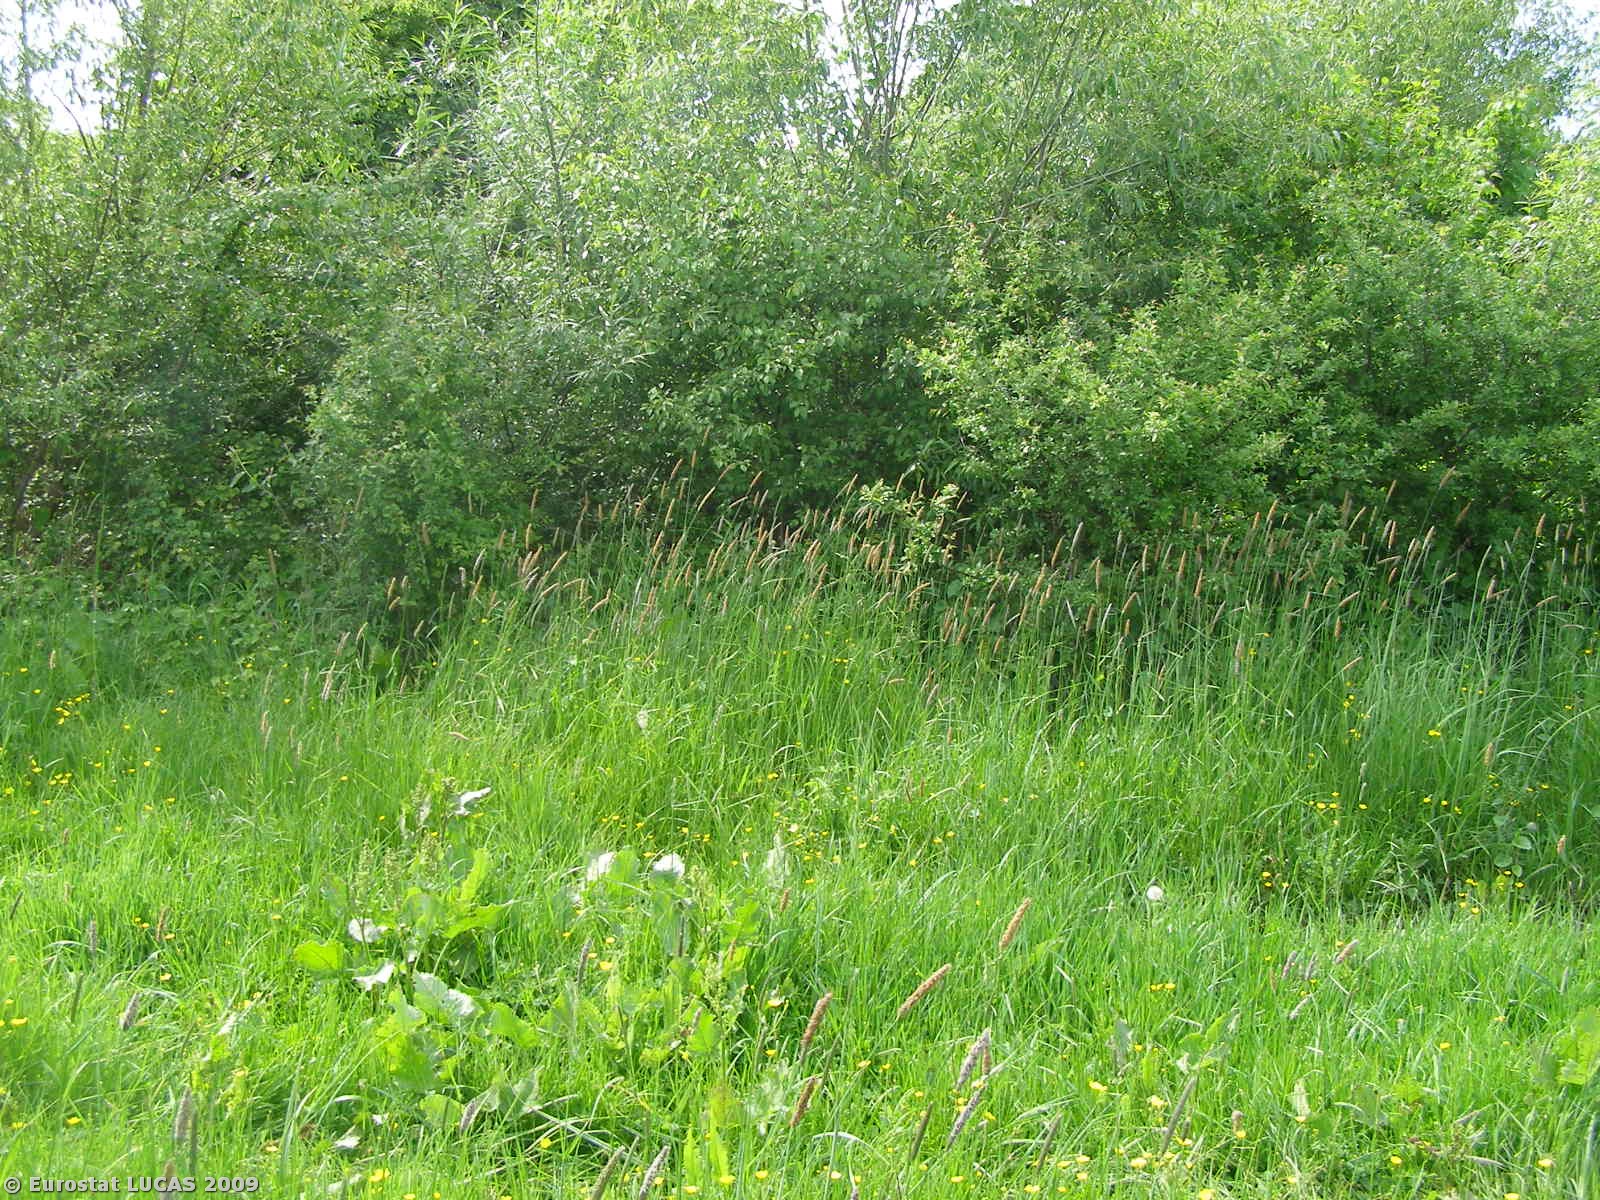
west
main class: Grassland
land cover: Grassland without tree/shrub cover
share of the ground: > 75 %
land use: Agriculture (excluding fallow land and kitchen gardens)
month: May
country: PL
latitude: 51.1399
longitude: 23.8554
